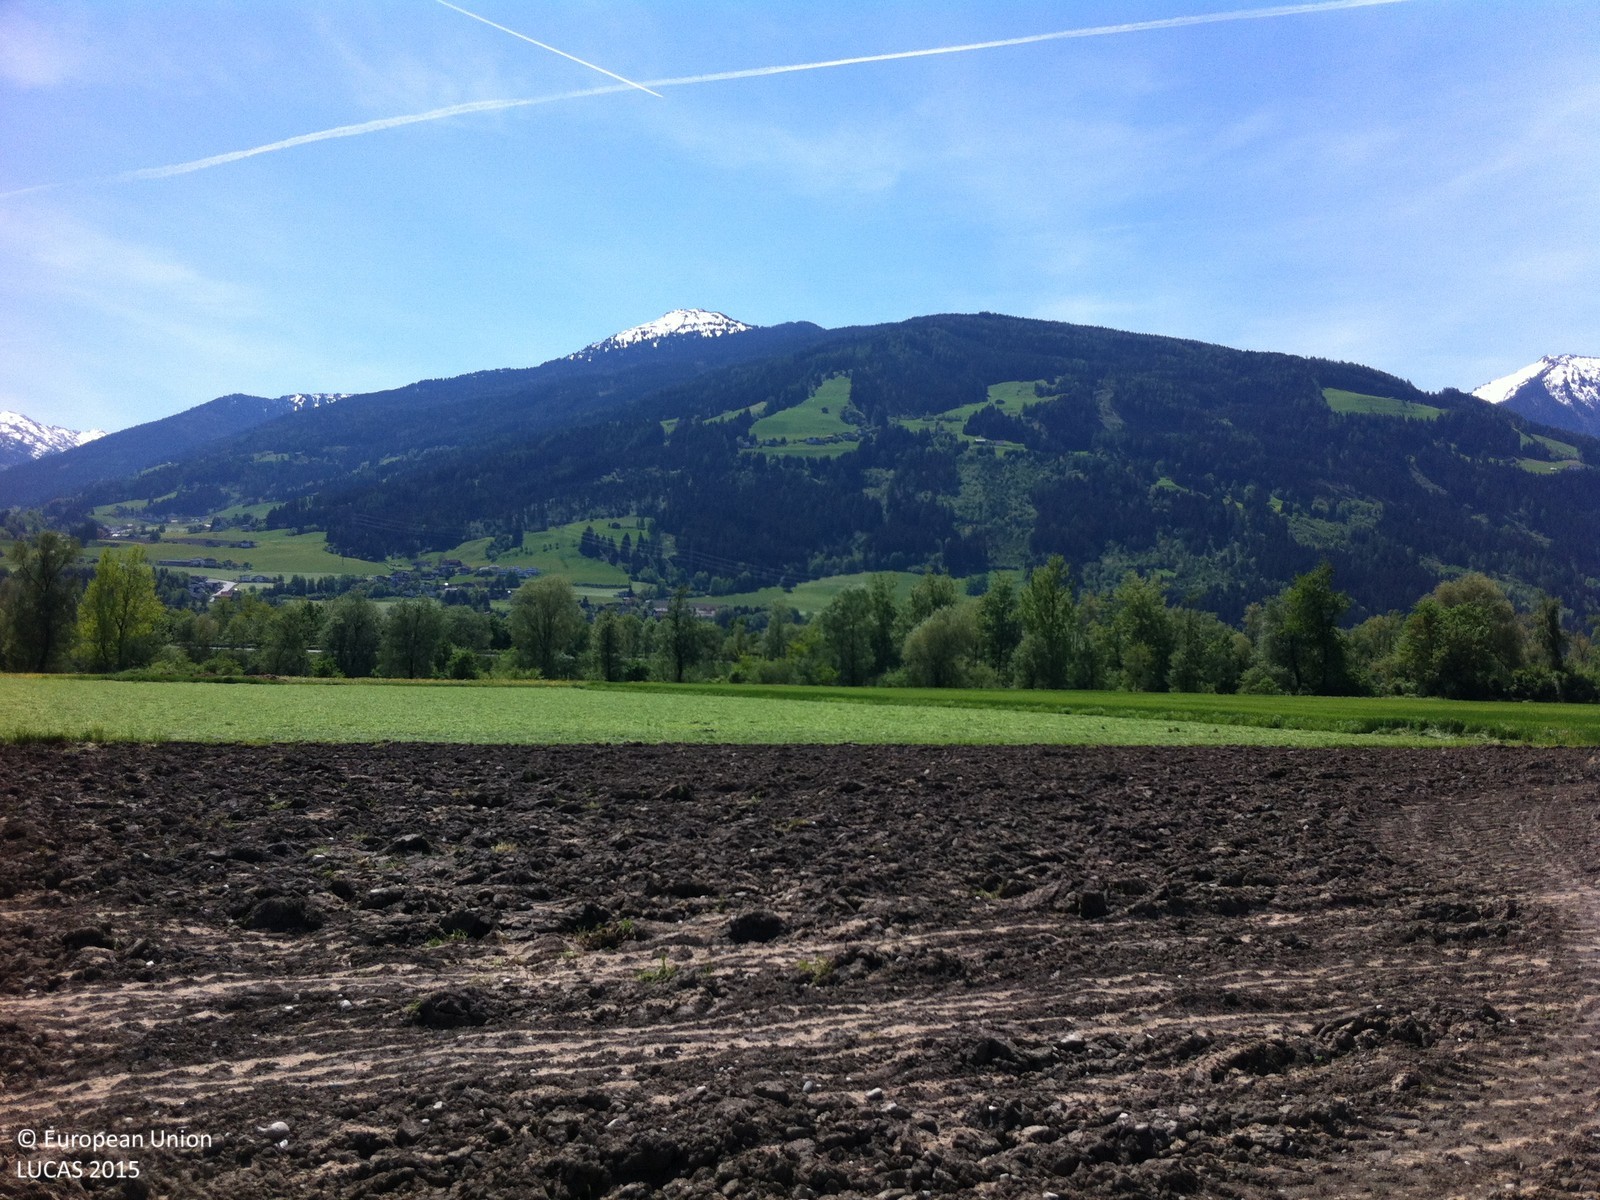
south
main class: Grassland
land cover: Spontaneously vegetated surfaces
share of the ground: > 75 %
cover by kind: herbaceous plants 90 %, shrubs 5 %, unconsolidated bare surface 5 %
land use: Abandoned areas
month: May
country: AT
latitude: 47.3115
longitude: 11.6256
